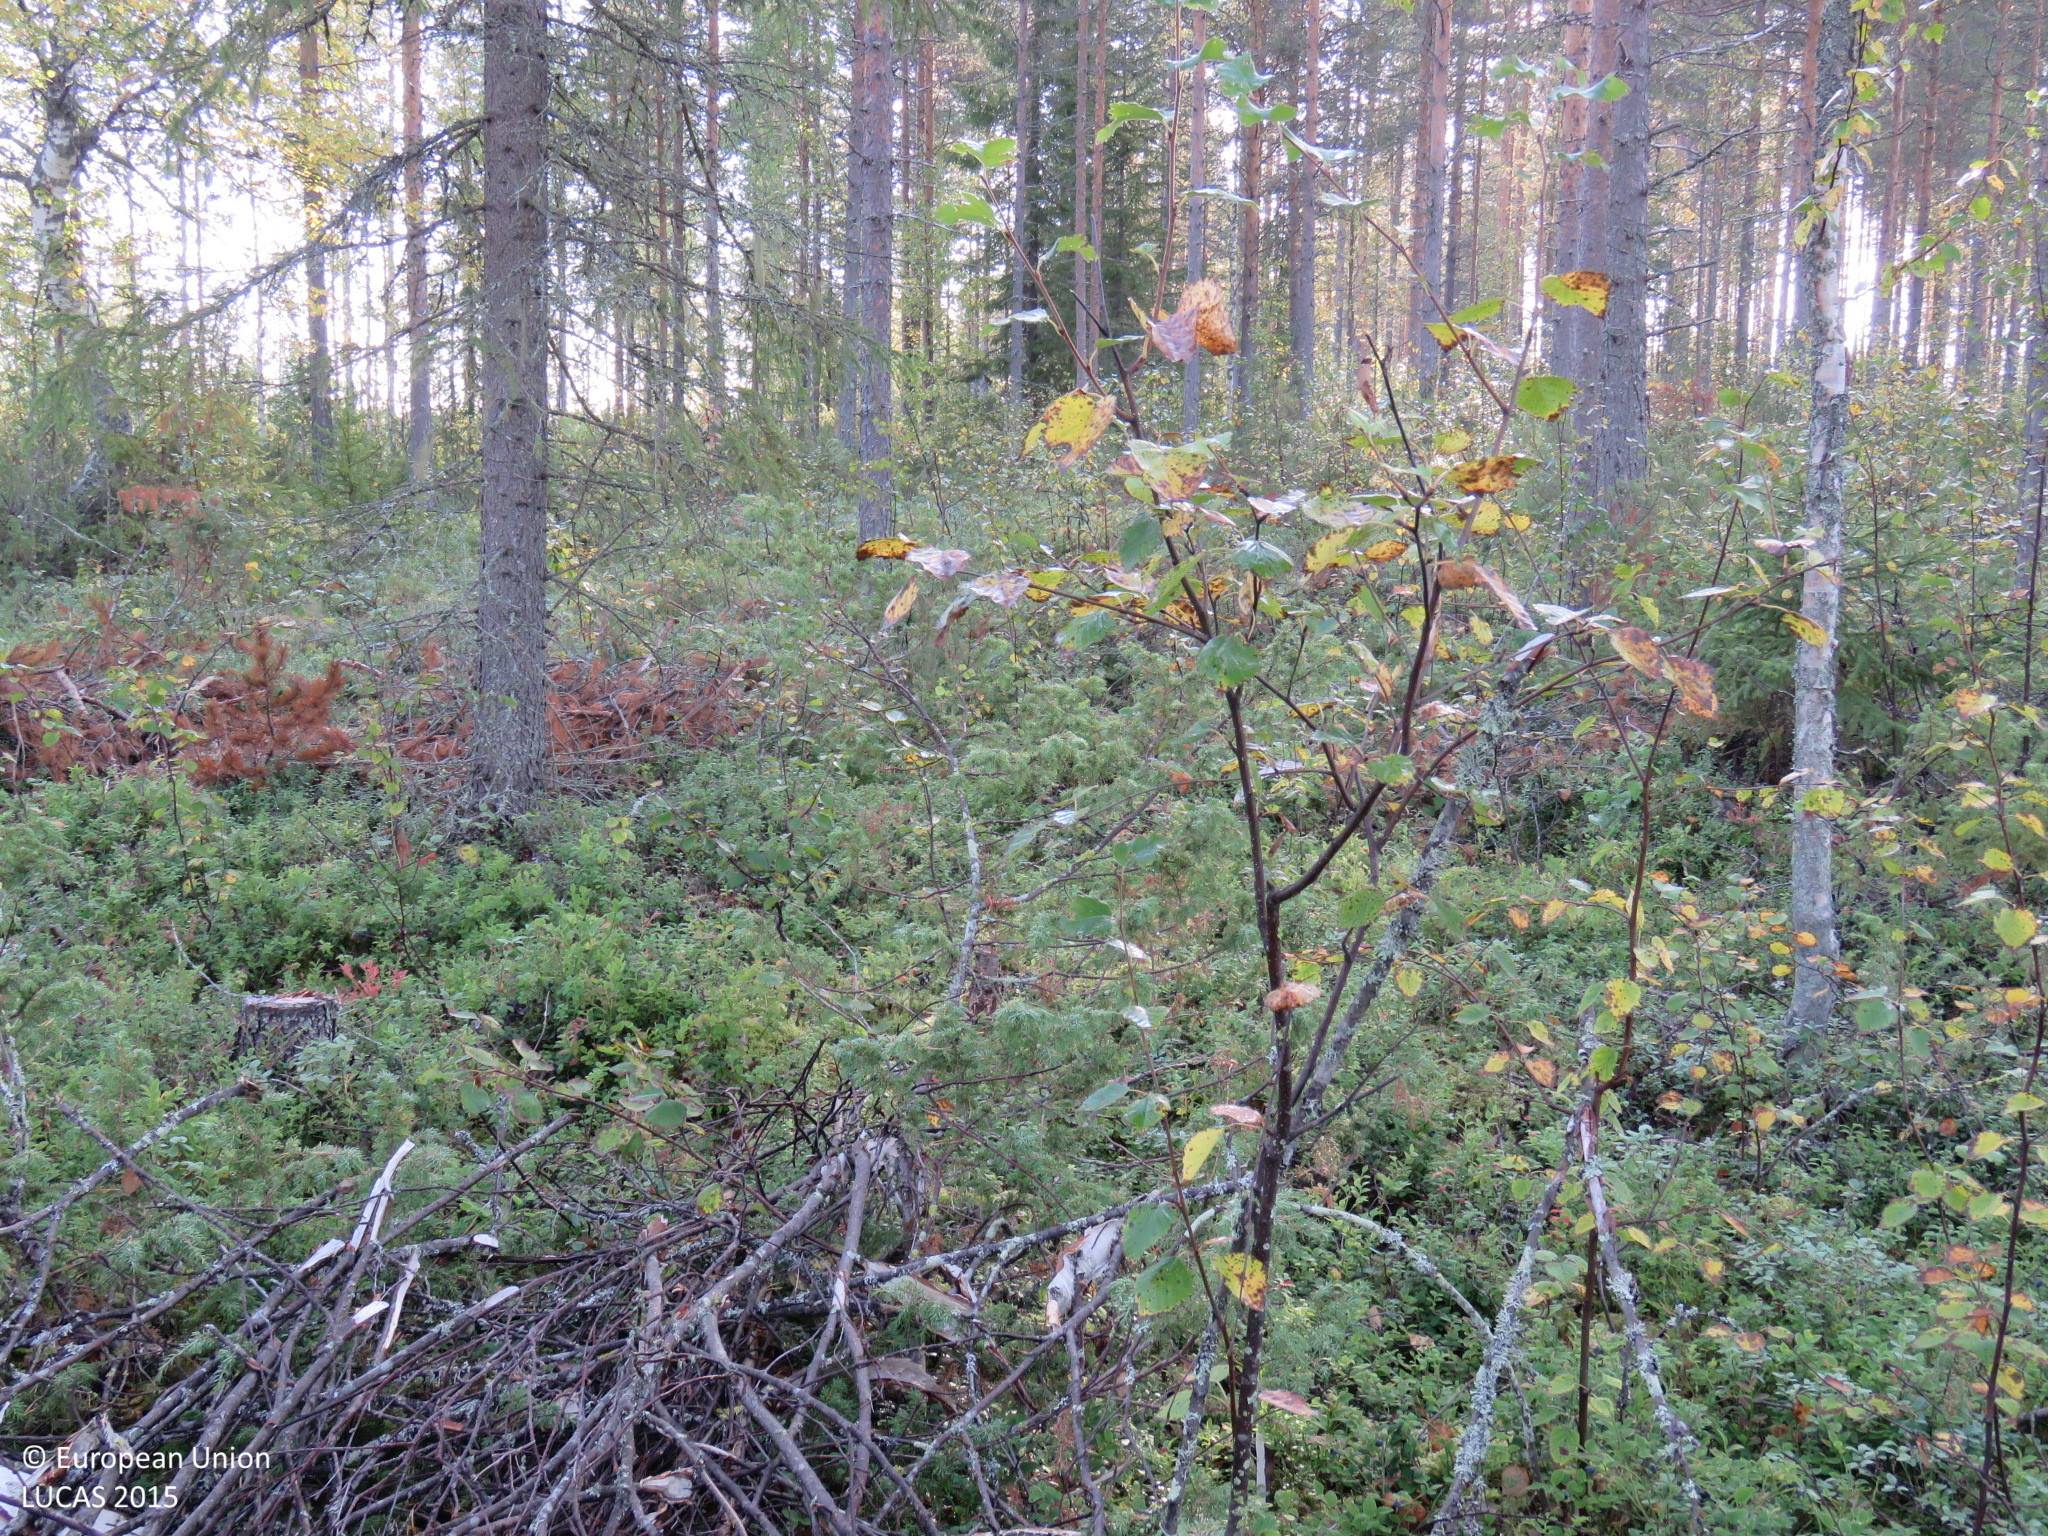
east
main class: Woodland
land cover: Pine dominated mixed woodland
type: boreal forest
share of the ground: > 75 %
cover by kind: coniferous forest trees 45 %, broadleaved forest trees 35 %, shrubs 20 %
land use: Forestry
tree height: > 5 m
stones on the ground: < 10 %
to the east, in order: Pine dominated mixed woodland; Other mixed woodland; Broadleaved woodland; Electric lines; Broadleaved woodland
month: September
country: FI
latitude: 65.4745
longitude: 27.5546
